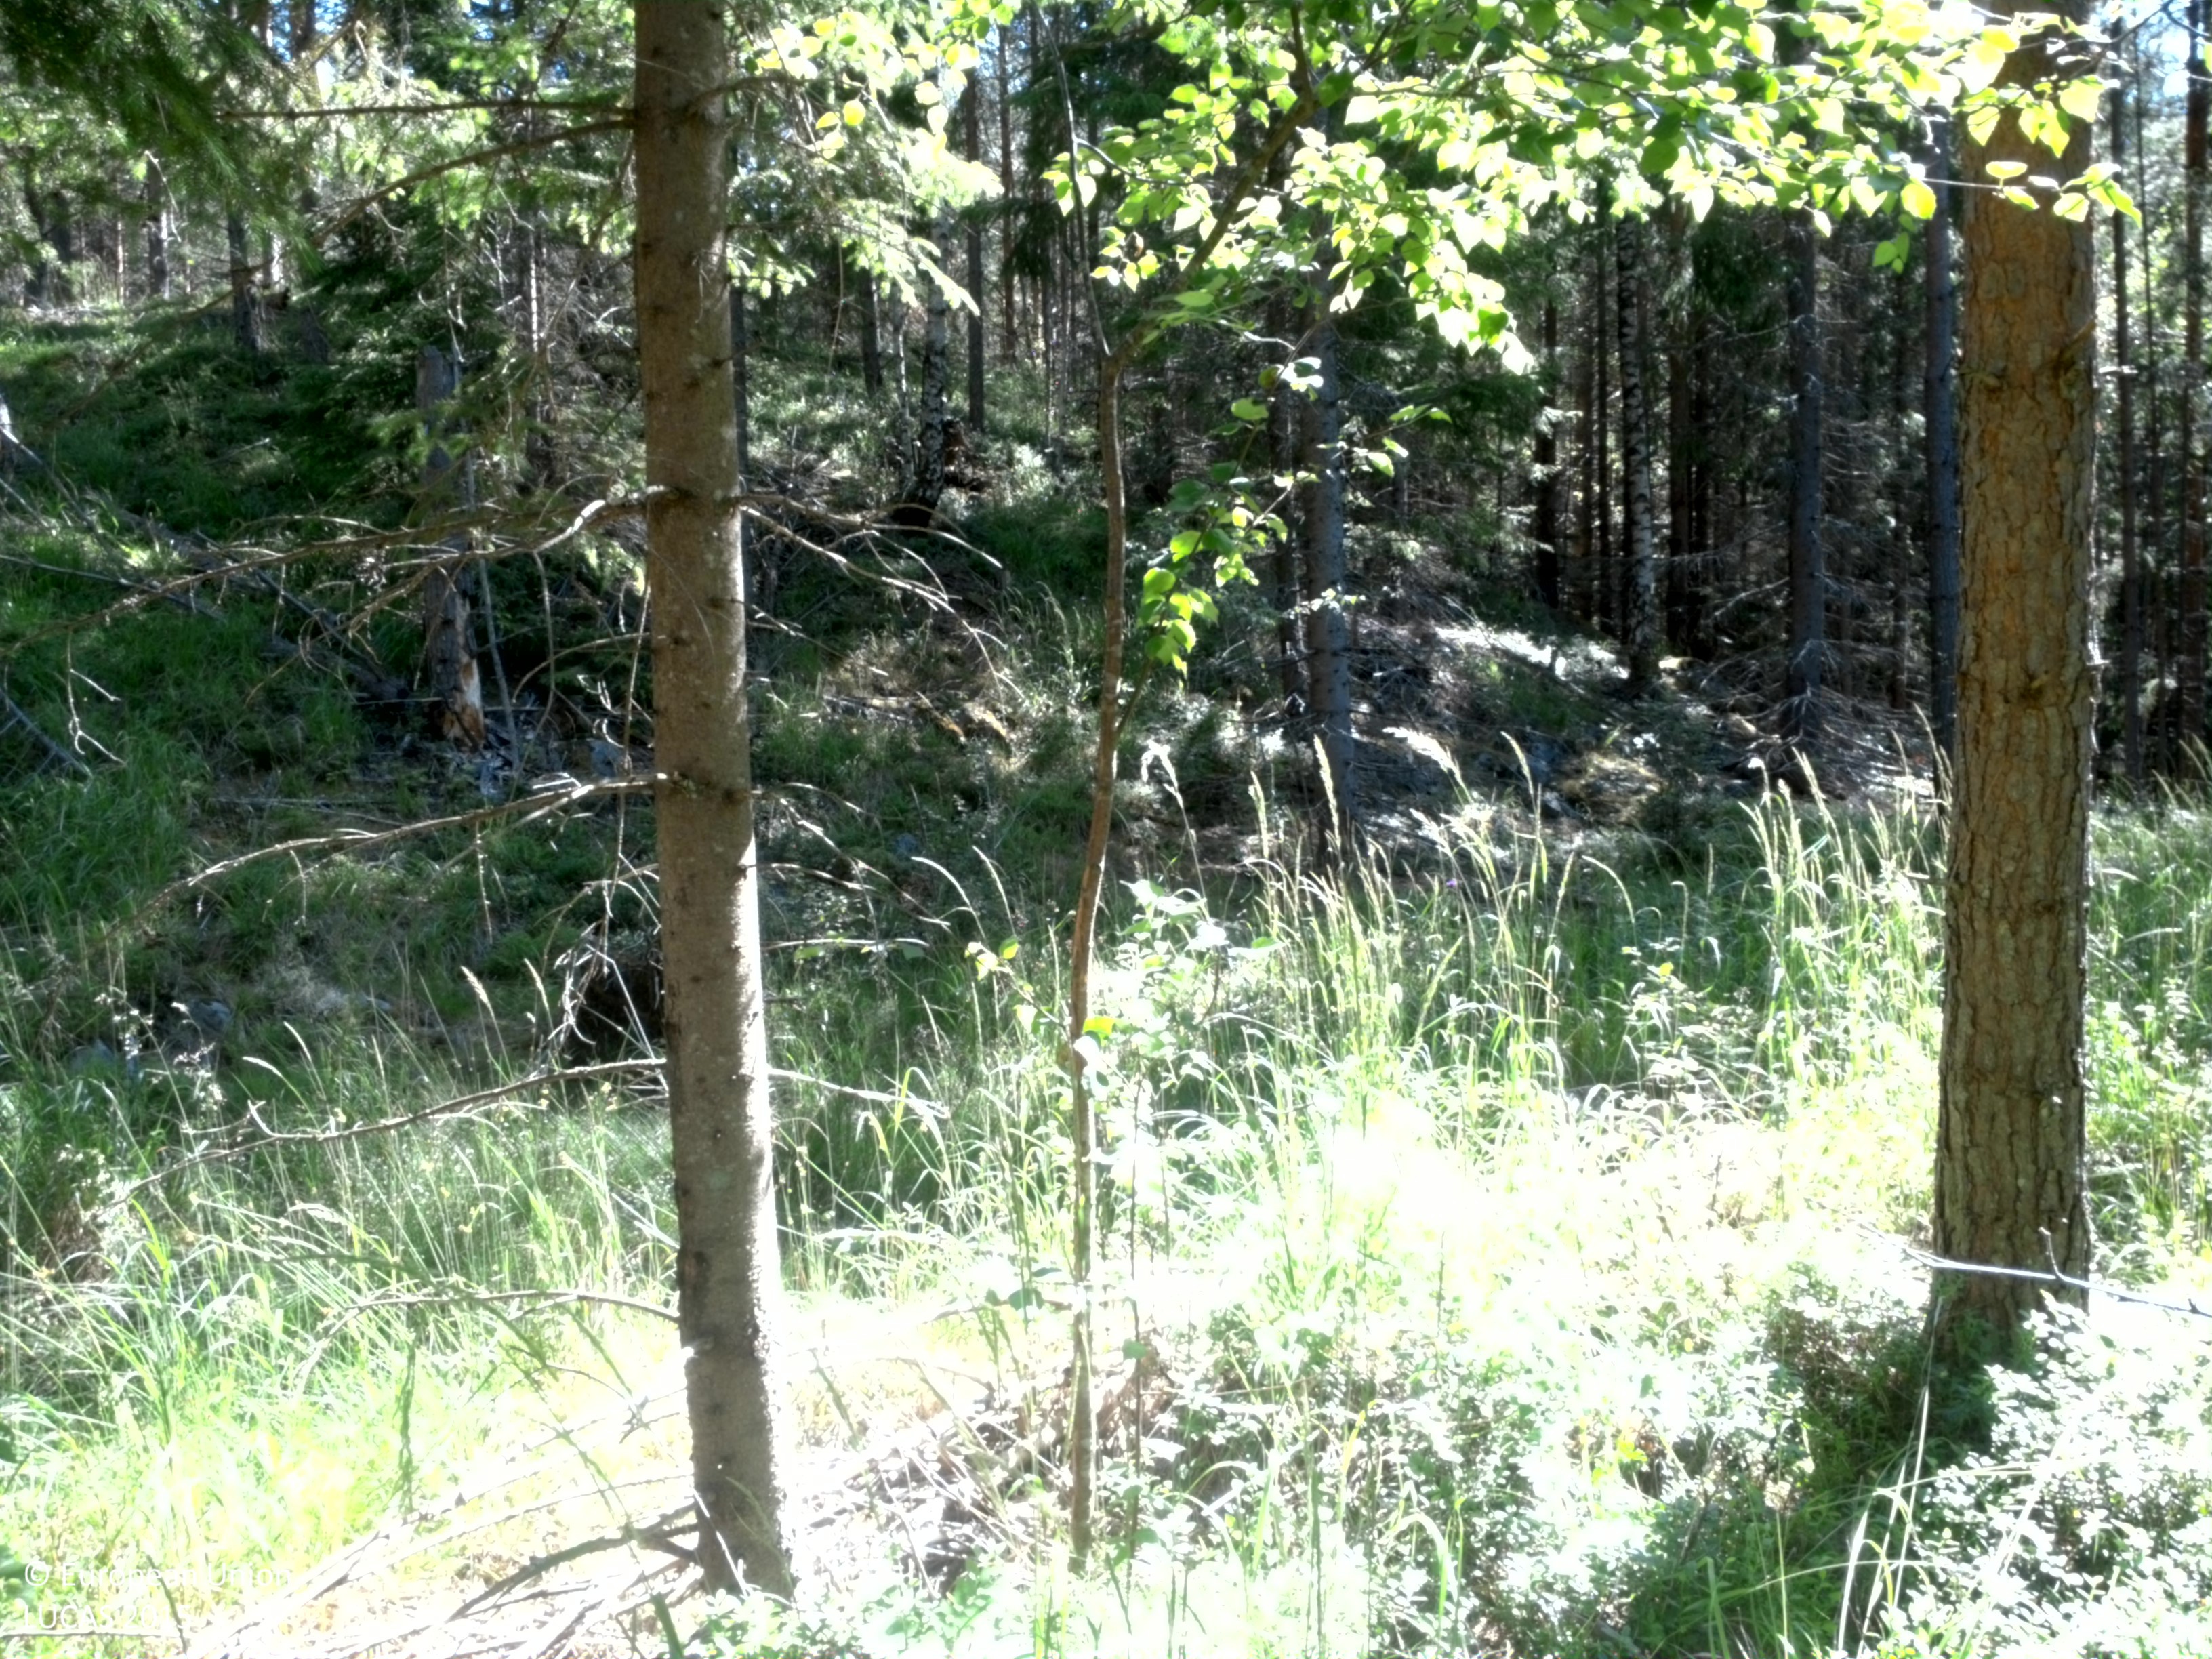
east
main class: Woodland
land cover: Pine dominated coniferous woodland
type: boreal forest
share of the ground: 50 - 75 %
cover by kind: coniferous forest trees 40 %, herbaceous plants 35 %, broadleaved forest trees 10 %, shrubs 10 %, lichens and mosses 5 %
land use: Forestry
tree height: > 5 m
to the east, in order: Pine dominated coniferous woodland; Tracks; Pine dominated coniferous woodland; Other coniferous woodland
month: July
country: SE
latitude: 59.6518
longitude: 14.6927
